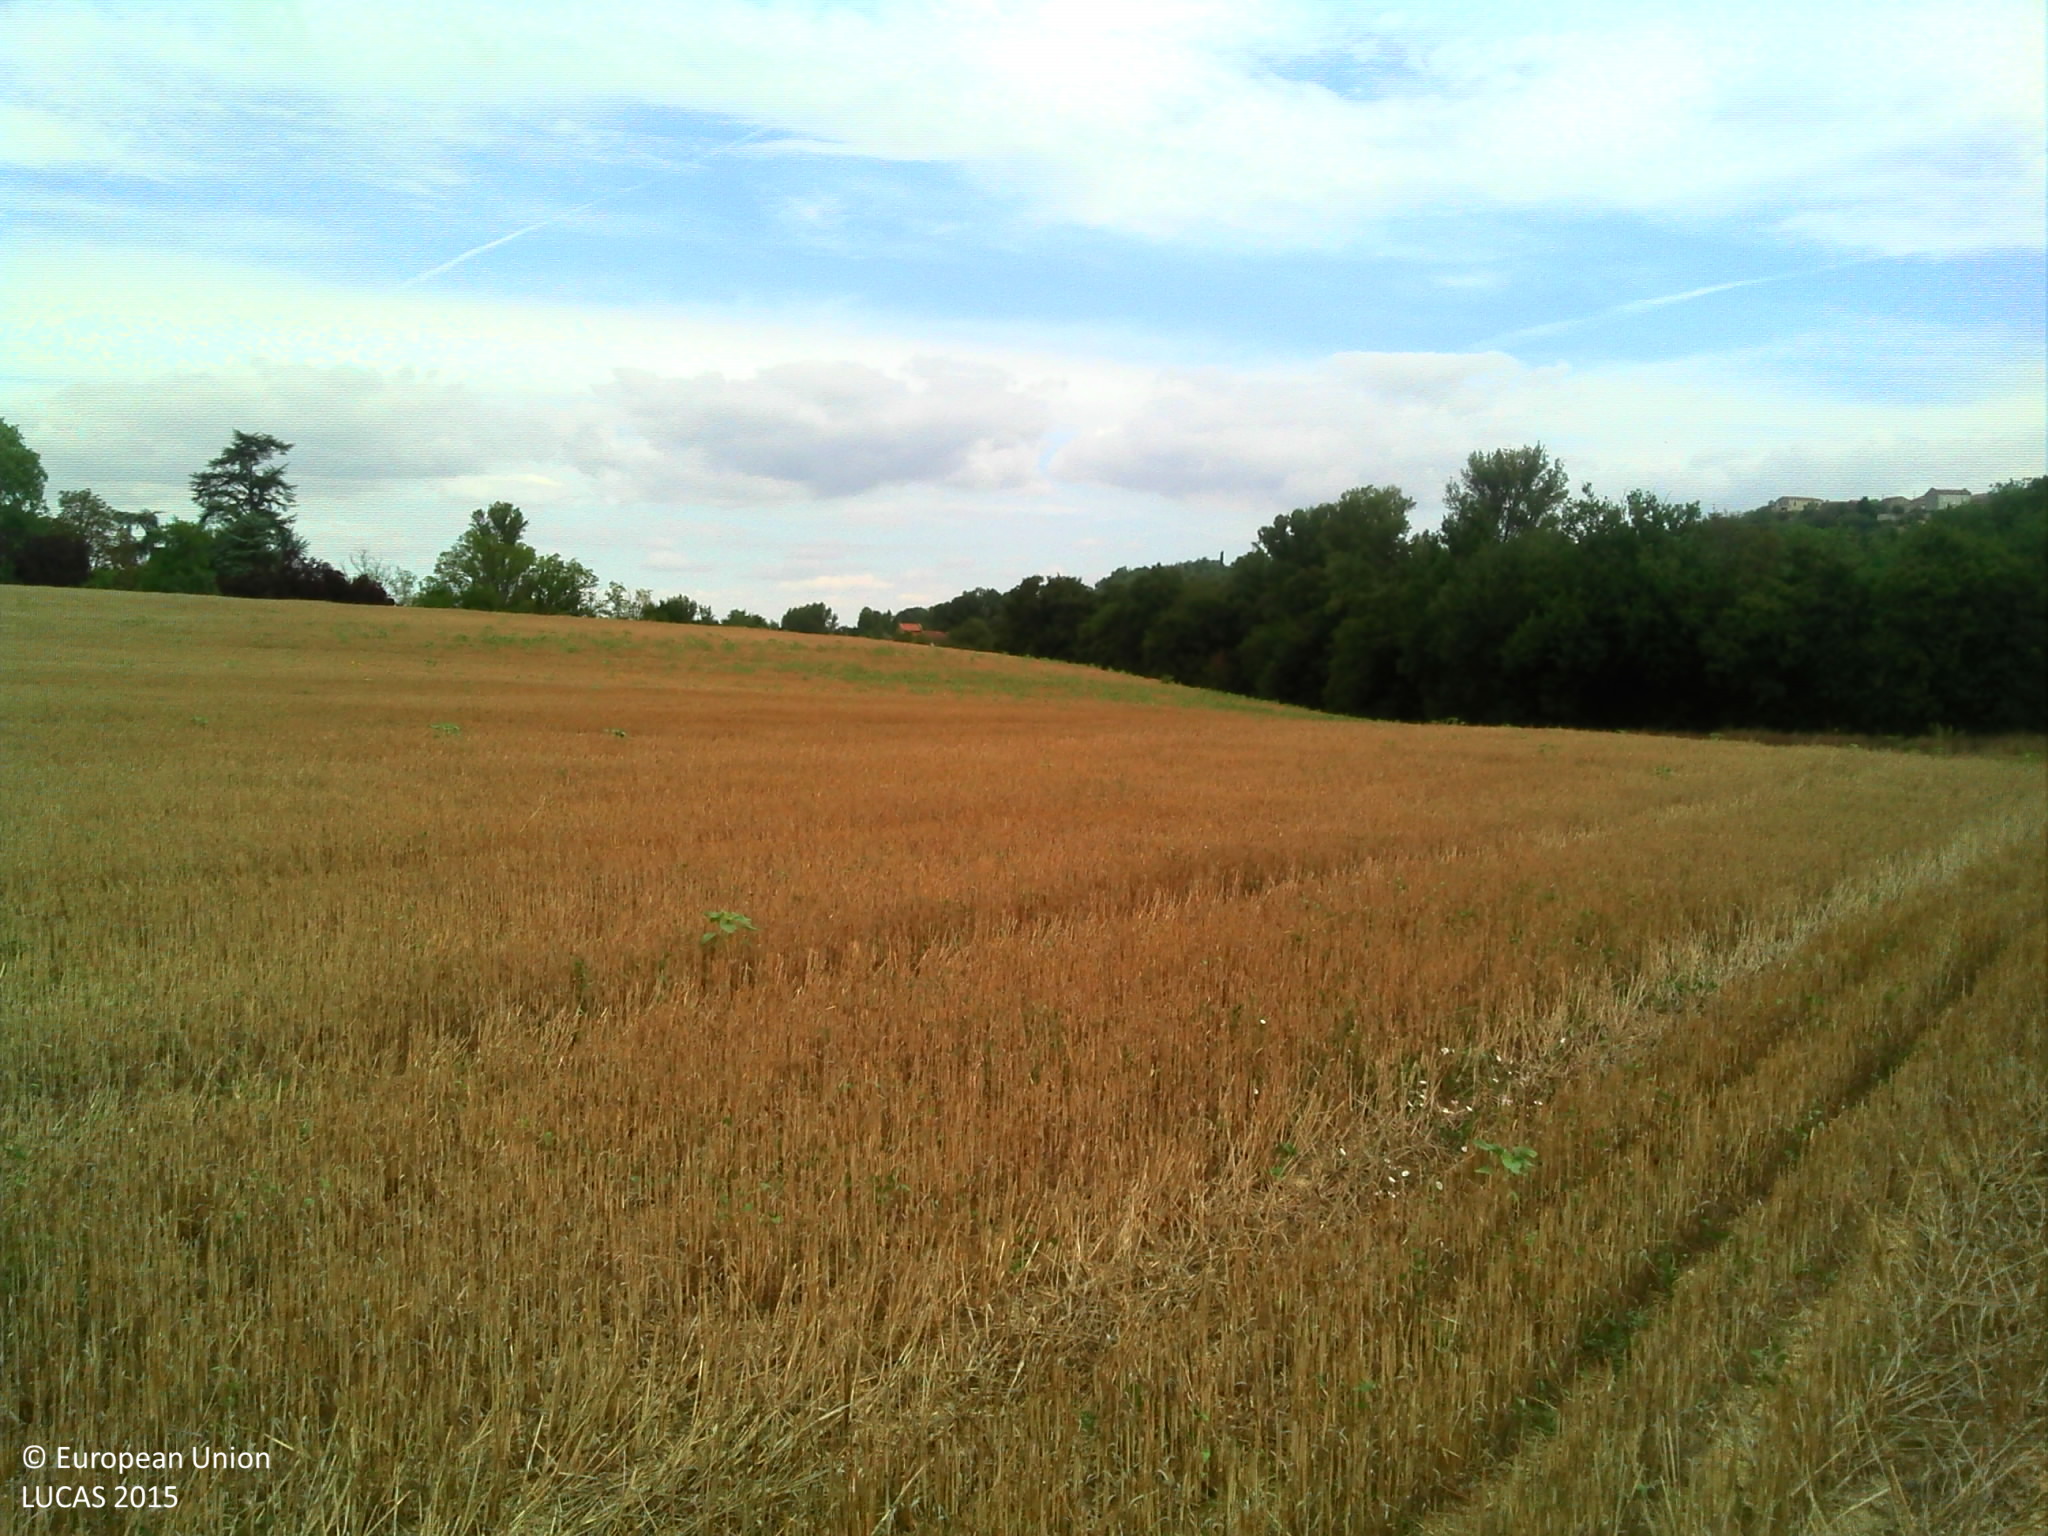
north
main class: Cropland
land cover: Common wheat
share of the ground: > 75 %
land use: Agriculture (excluding fallow land and kitchen gardens)
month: July
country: FR
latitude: 44.0767
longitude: 0.6931
